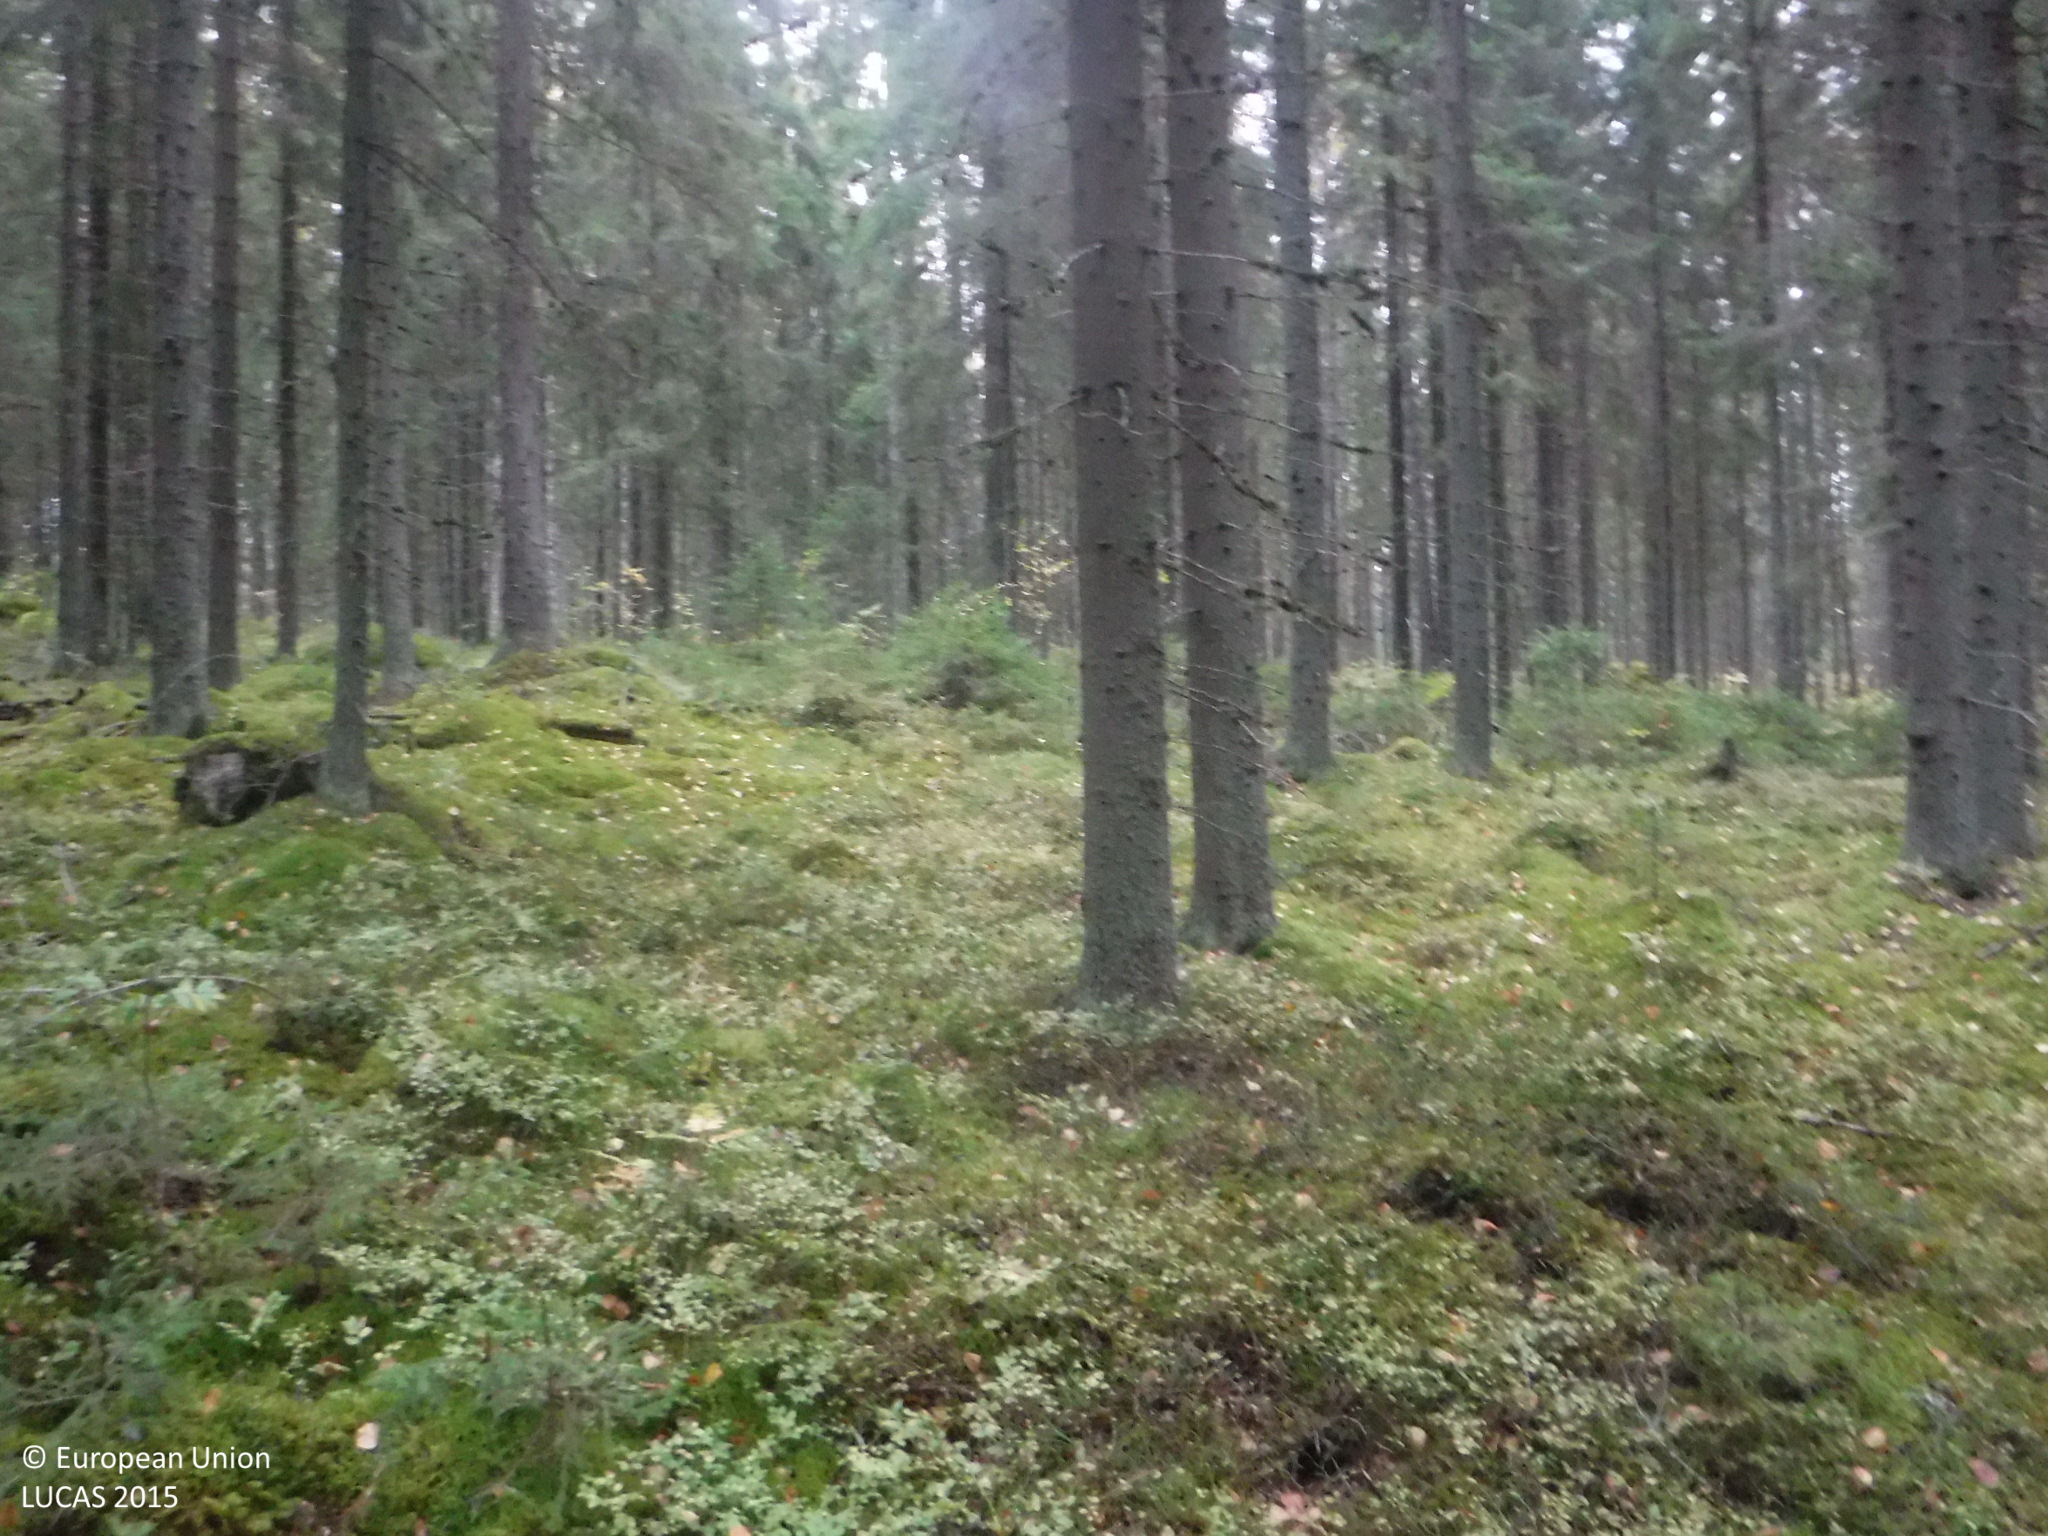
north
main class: Woodland
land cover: Spruce dominated coniferous woodland
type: boreal forest
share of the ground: > 75 %
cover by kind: coniferous forest trees 70 %, lichens and mosses 20 %, broadleaved forest trees 5 %, shrubs 5 %
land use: Forestry
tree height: > 5 m
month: September
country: FI
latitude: 61.7195
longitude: 23.9544
